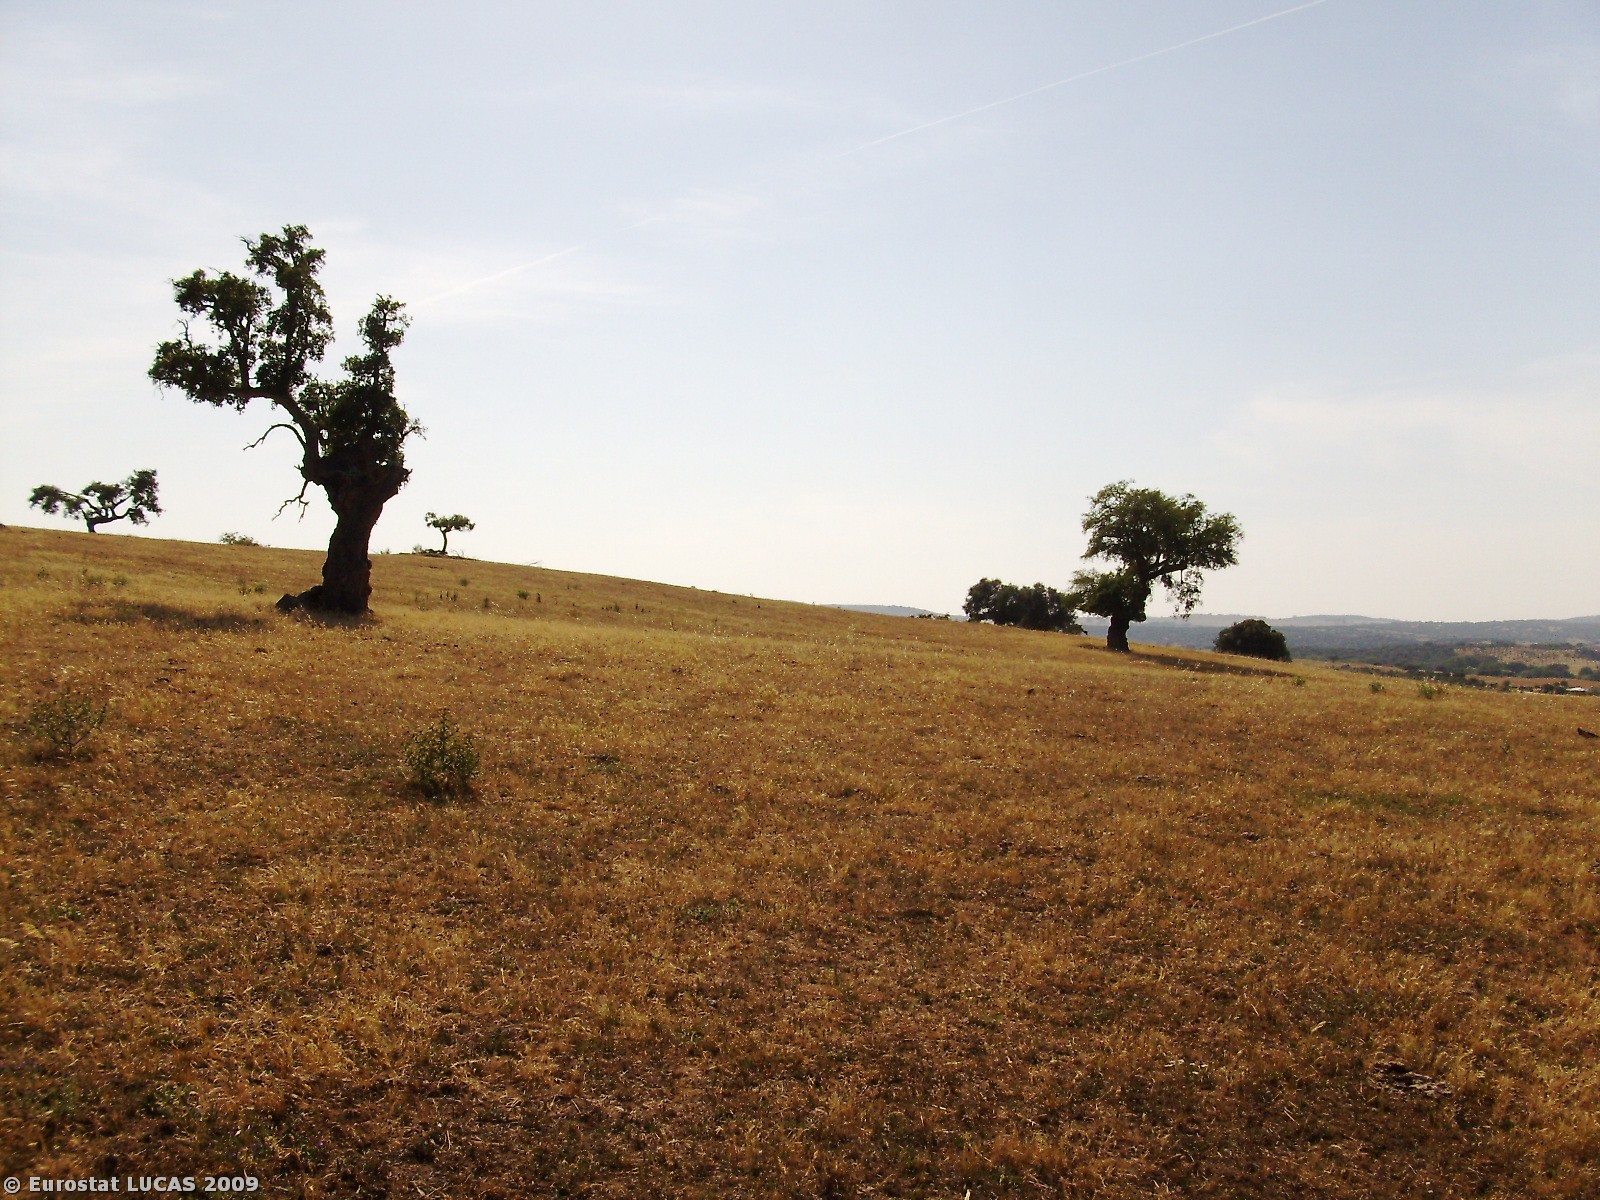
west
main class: Grassland
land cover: Grassland without tree/shrub cover
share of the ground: > 75 %
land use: Agriculture (excluding fallow land and kitchen gardens)
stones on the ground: 10 - 25 %
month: June
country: PT
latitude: 39.0667
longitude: -7.4079
